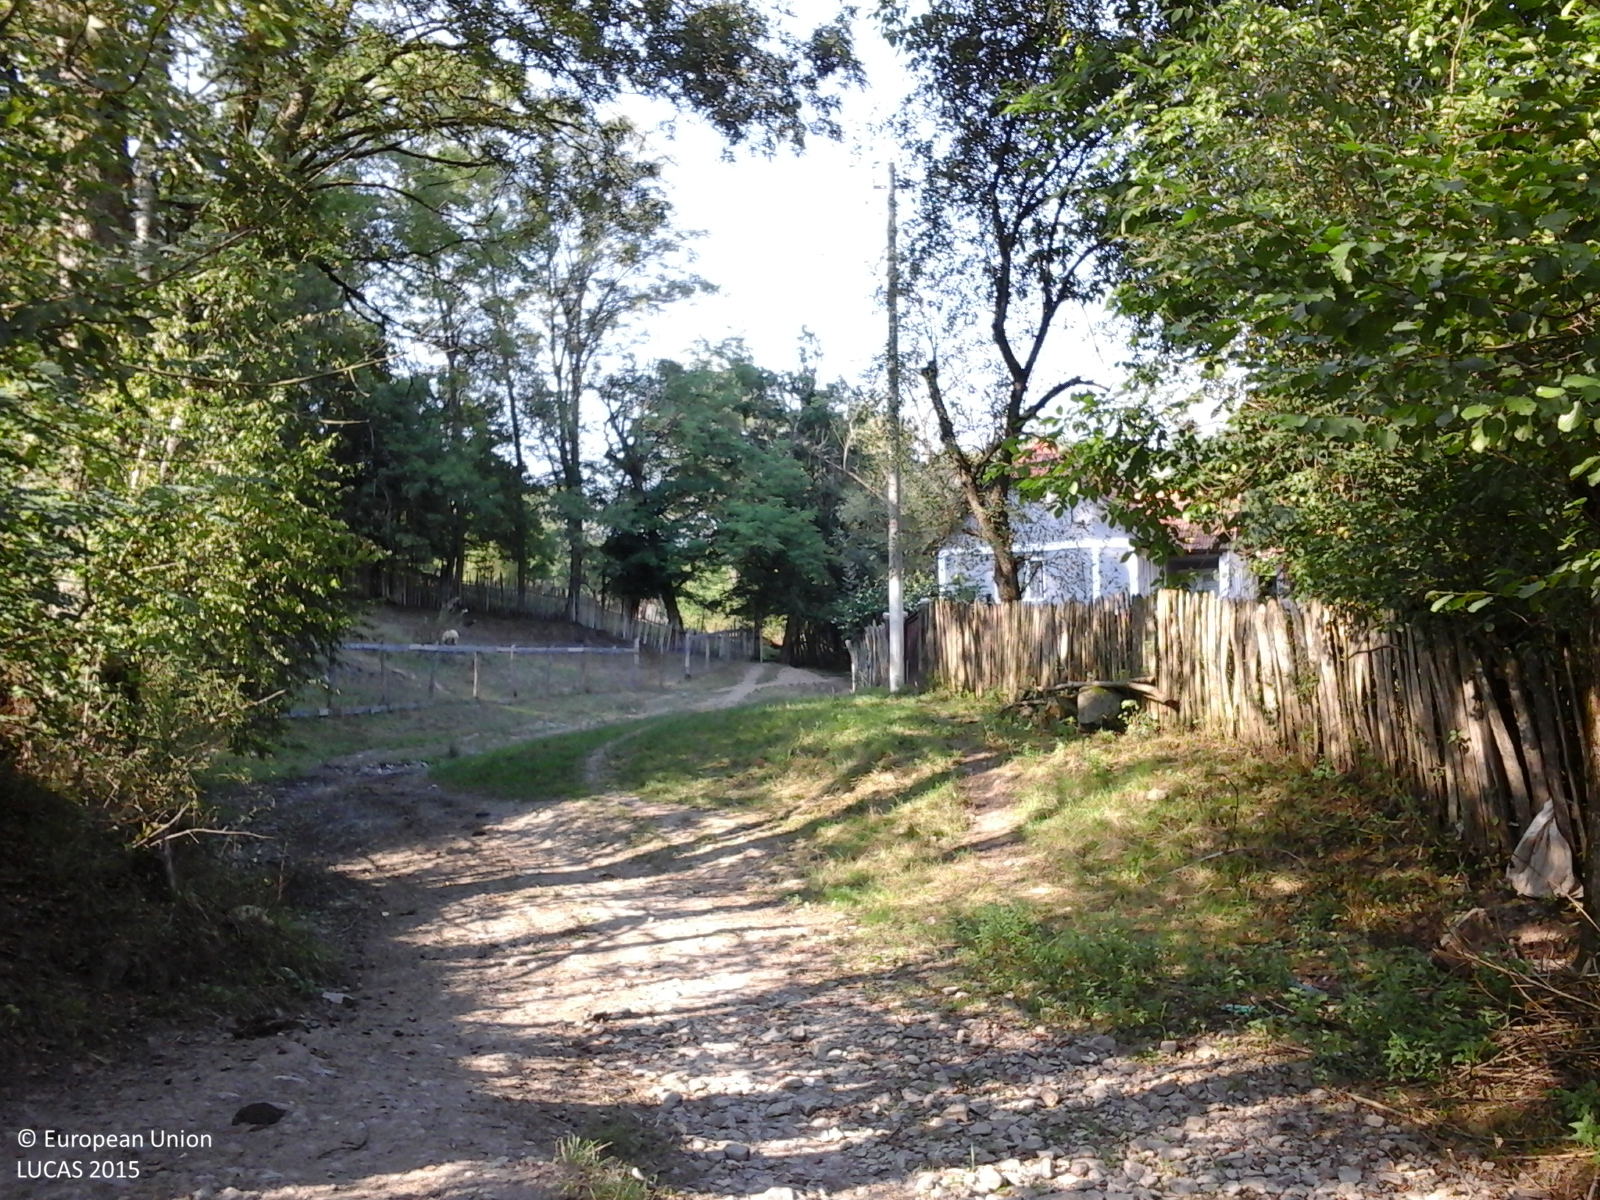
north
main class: Cropland
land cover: Lucerne
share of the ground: > 75 %
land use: Agriculture (excluding fallow land and kitchen gardens)
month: August
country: RO
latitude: 46.0999
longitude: 22.0864
